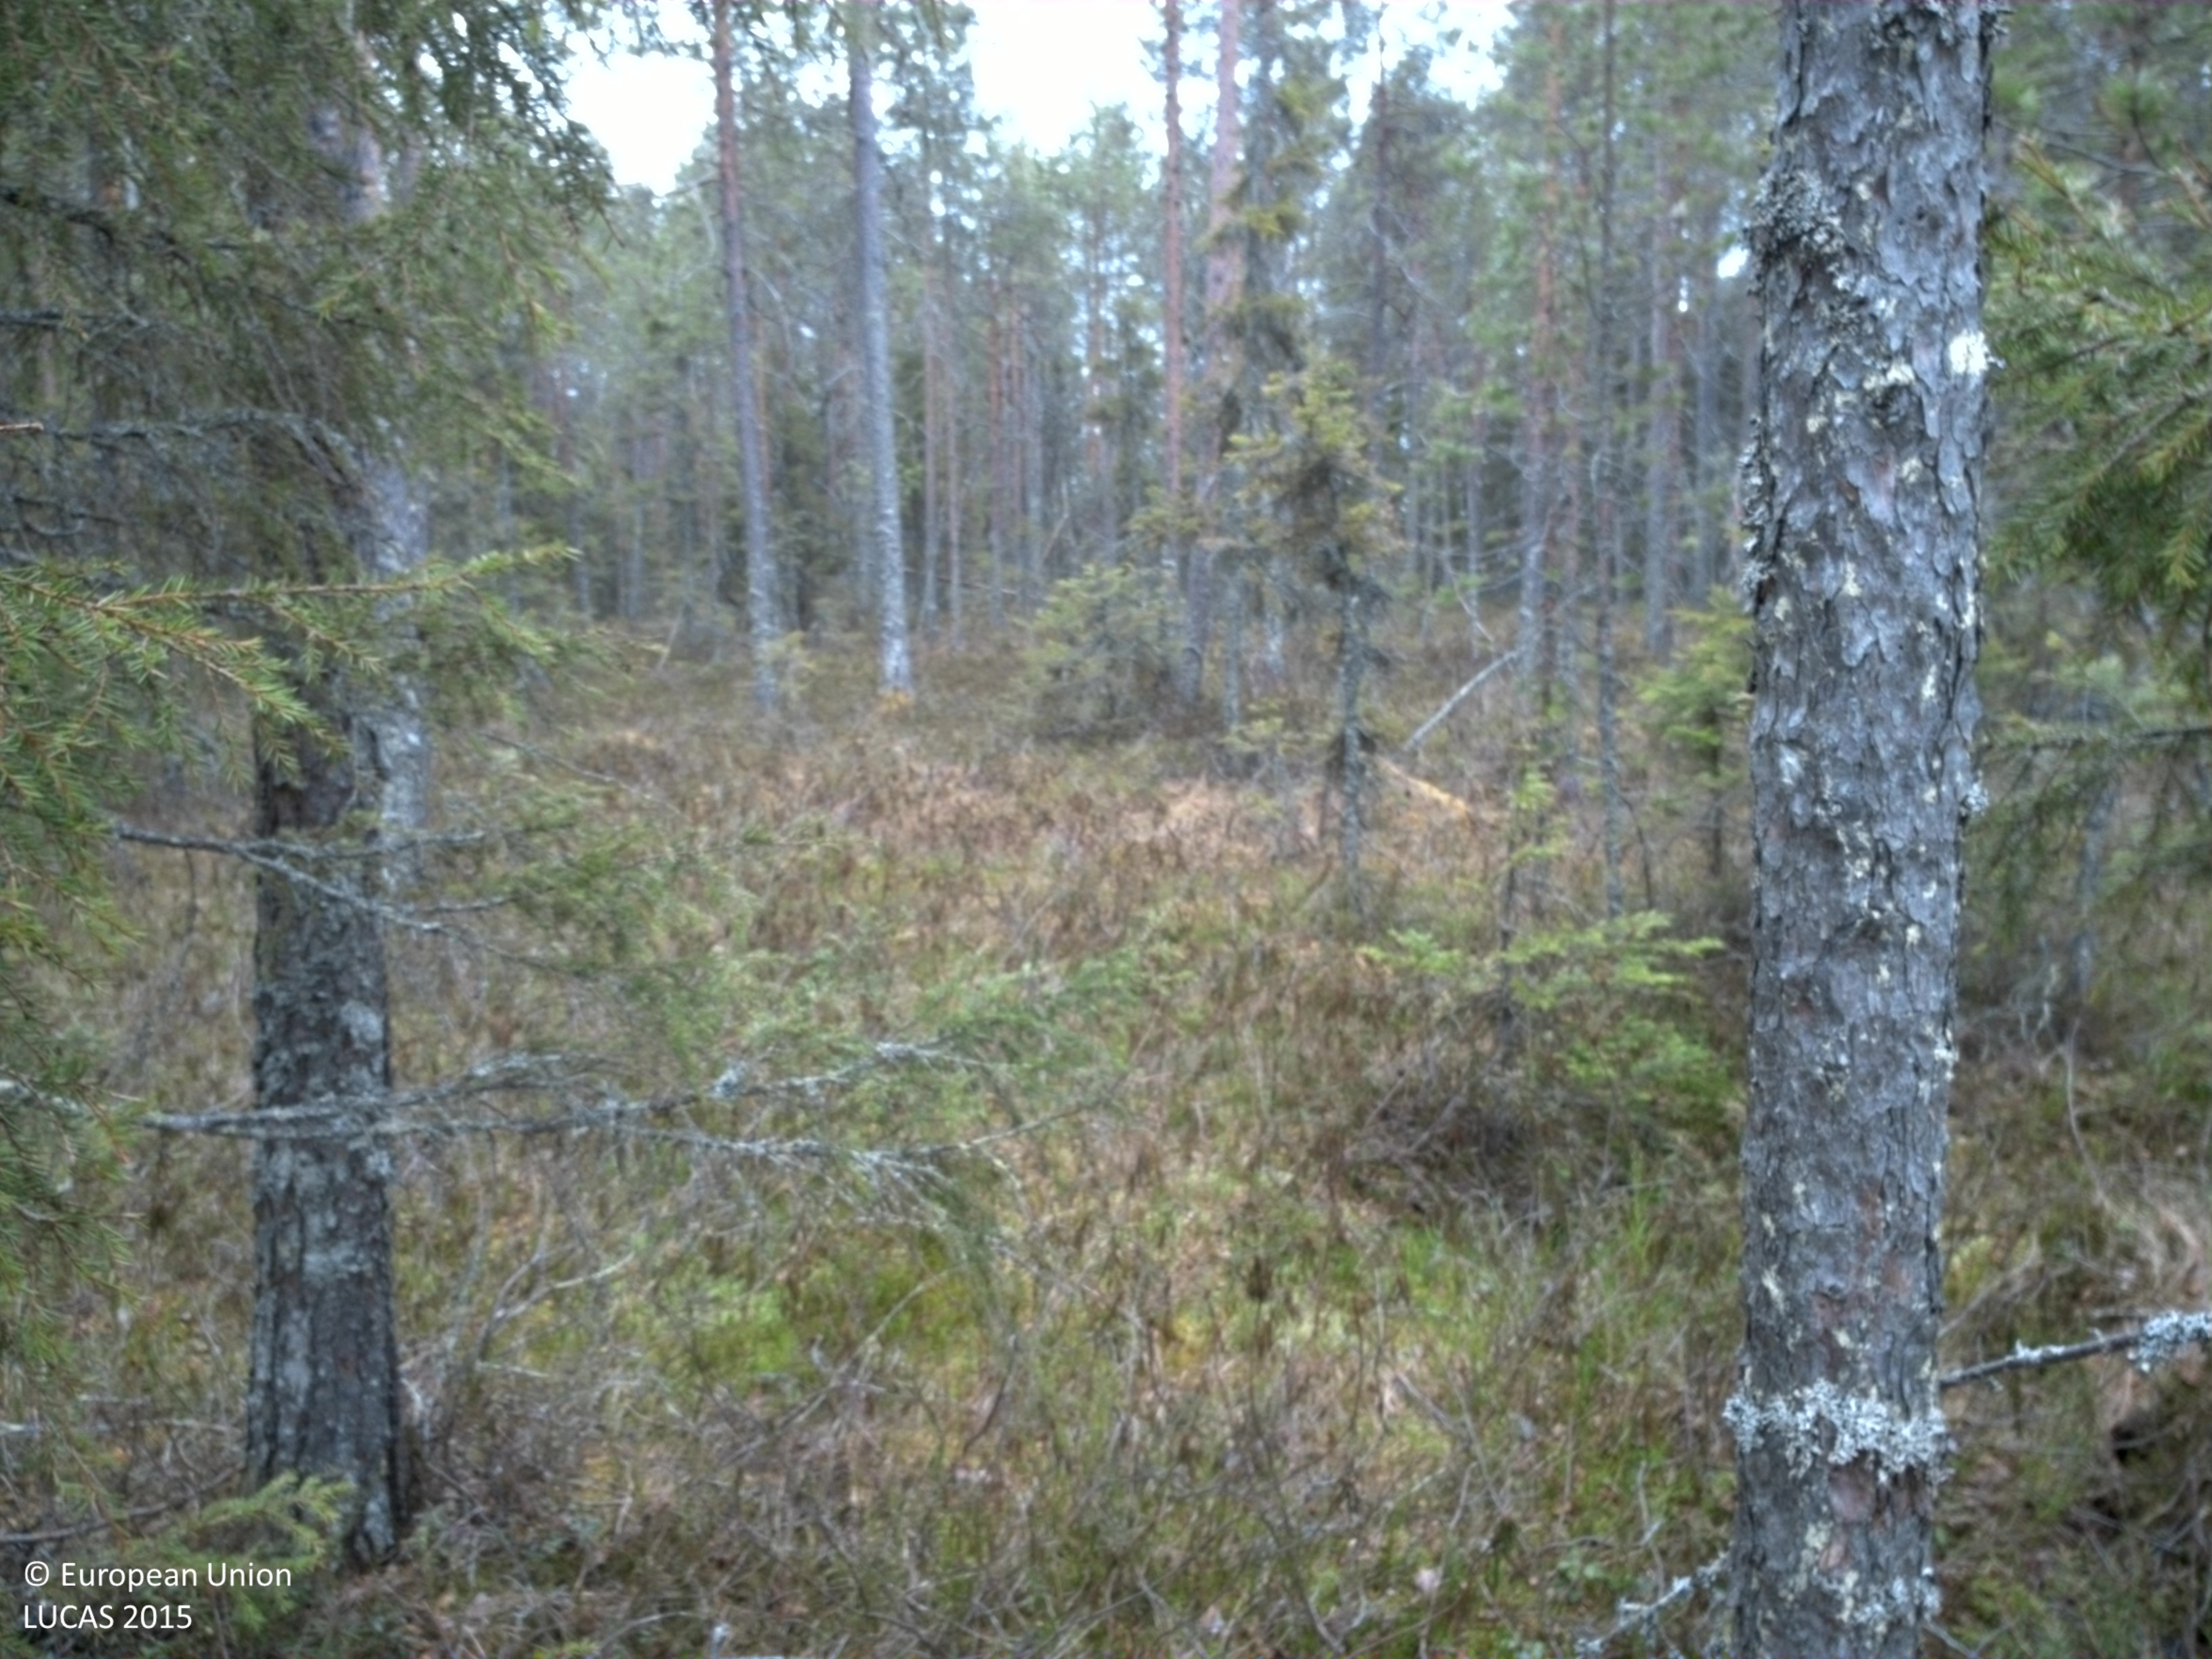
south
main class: Woodland
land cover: Pine dominated coniferous woodland
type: boreal forest
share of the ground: 50 - 75 %
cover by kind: coniferous forest trees 60 %, shrubs 40 %
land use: Forestry
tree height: > 5 m
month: May
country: SE
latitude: 65.8536
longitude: 22.8884
